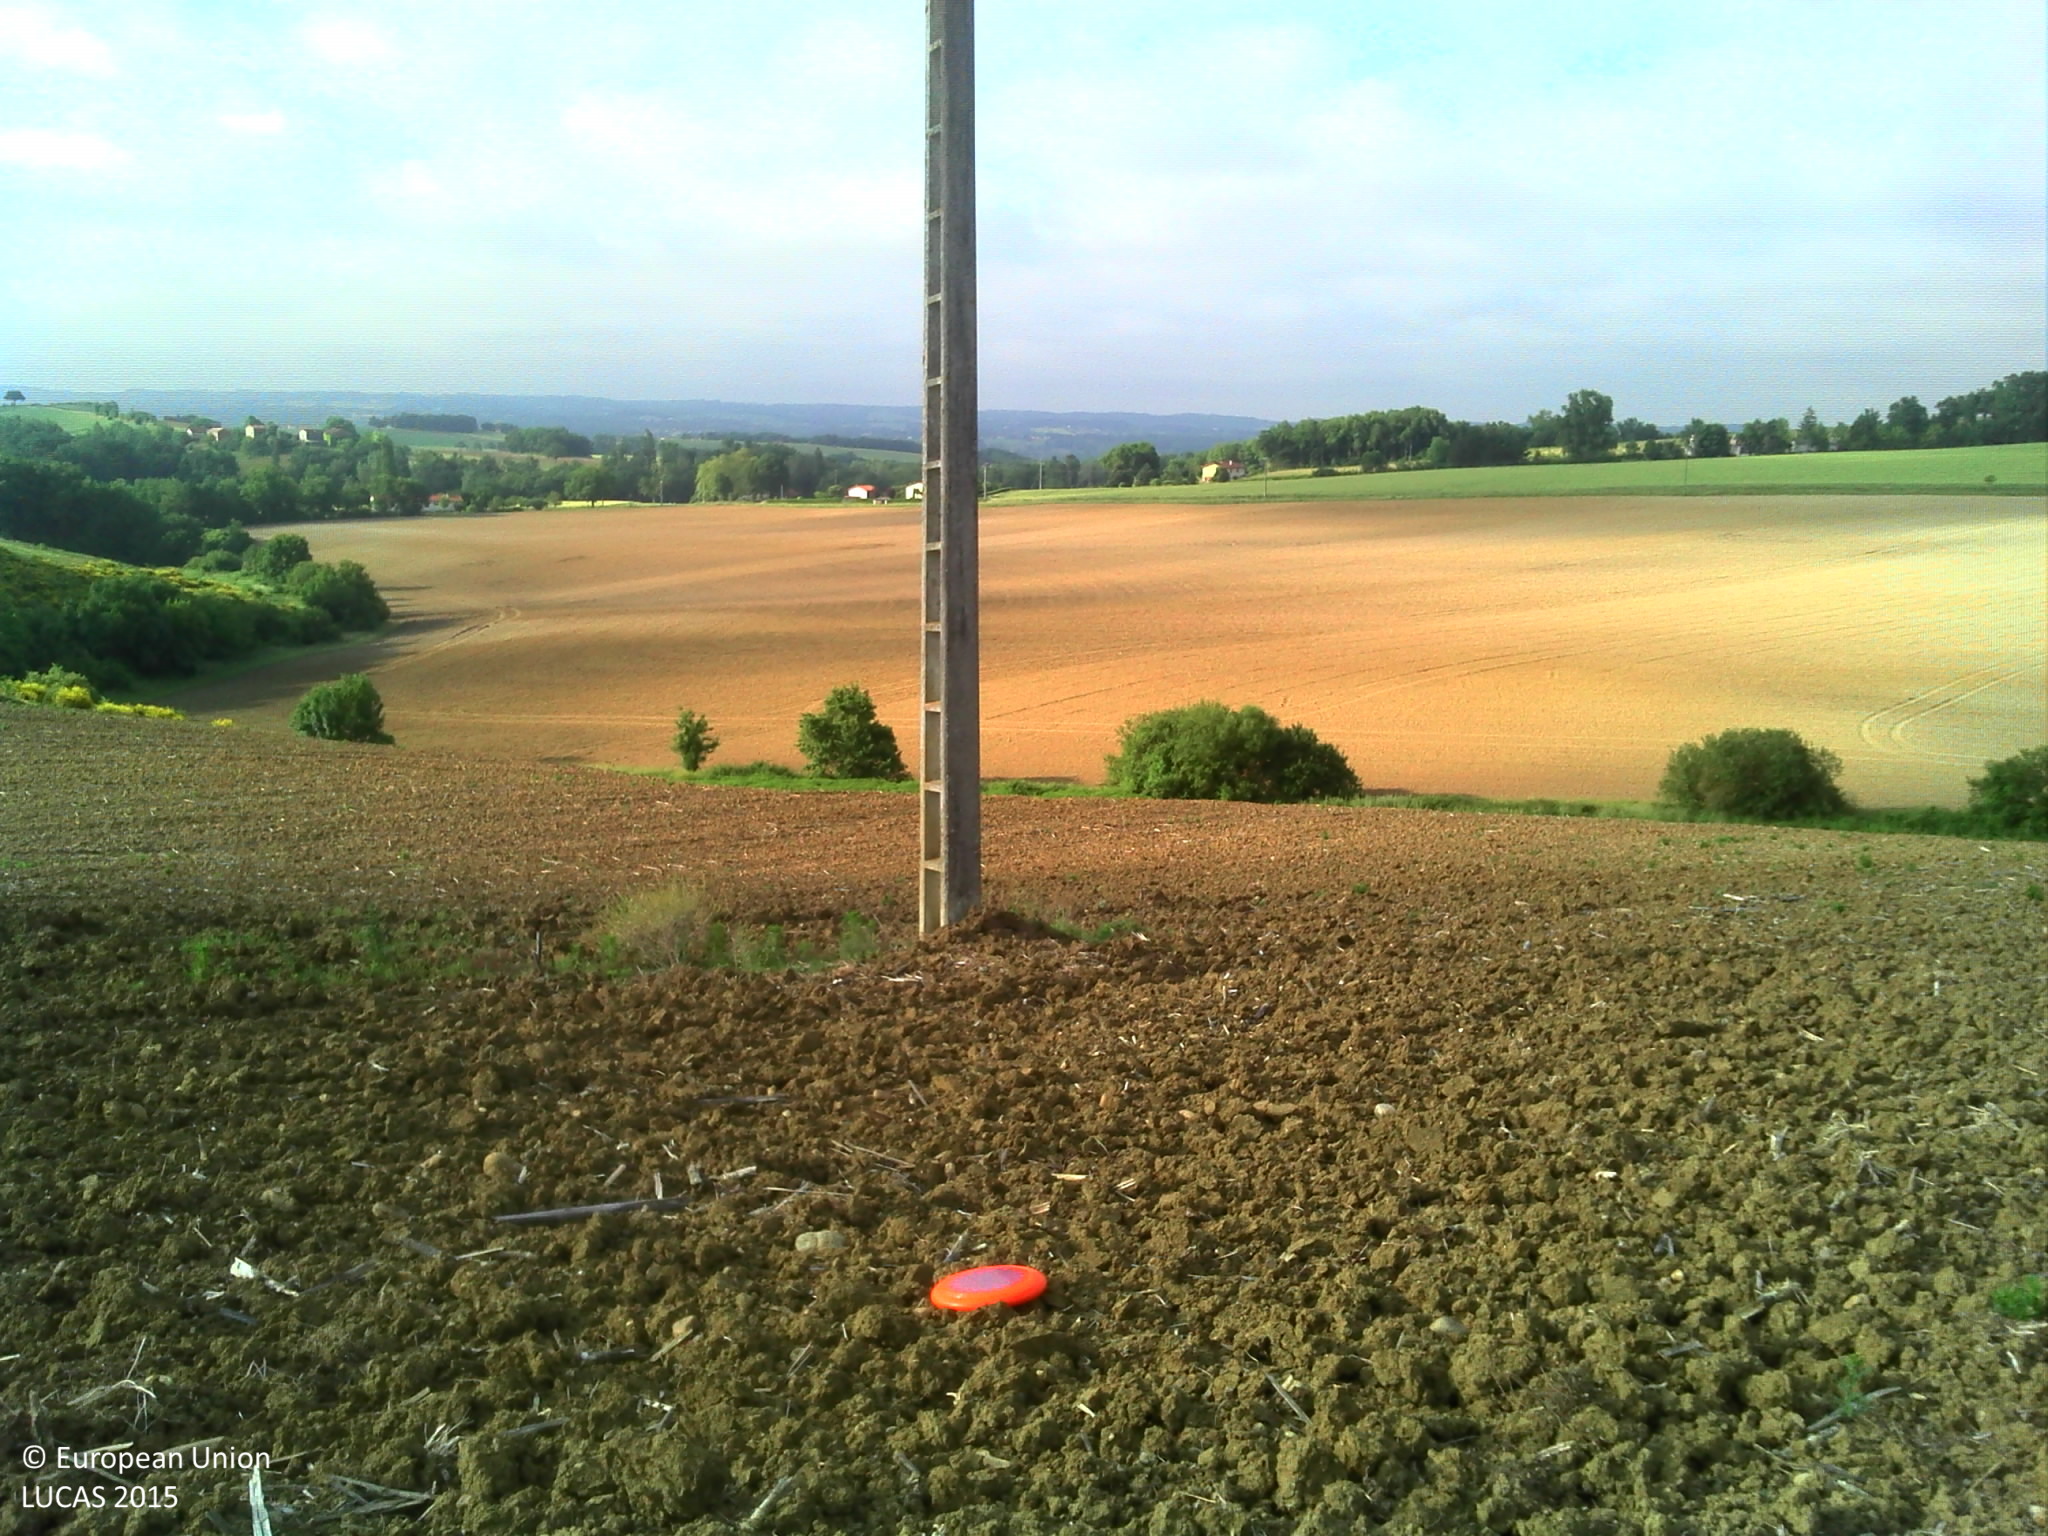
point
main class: Cropland
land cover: Sunflower
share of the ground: < 10 %
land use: Agriculture (excluding fallow land and kitchen gardens)
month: May
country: FR
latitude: 43.8028
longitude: 1.9617
